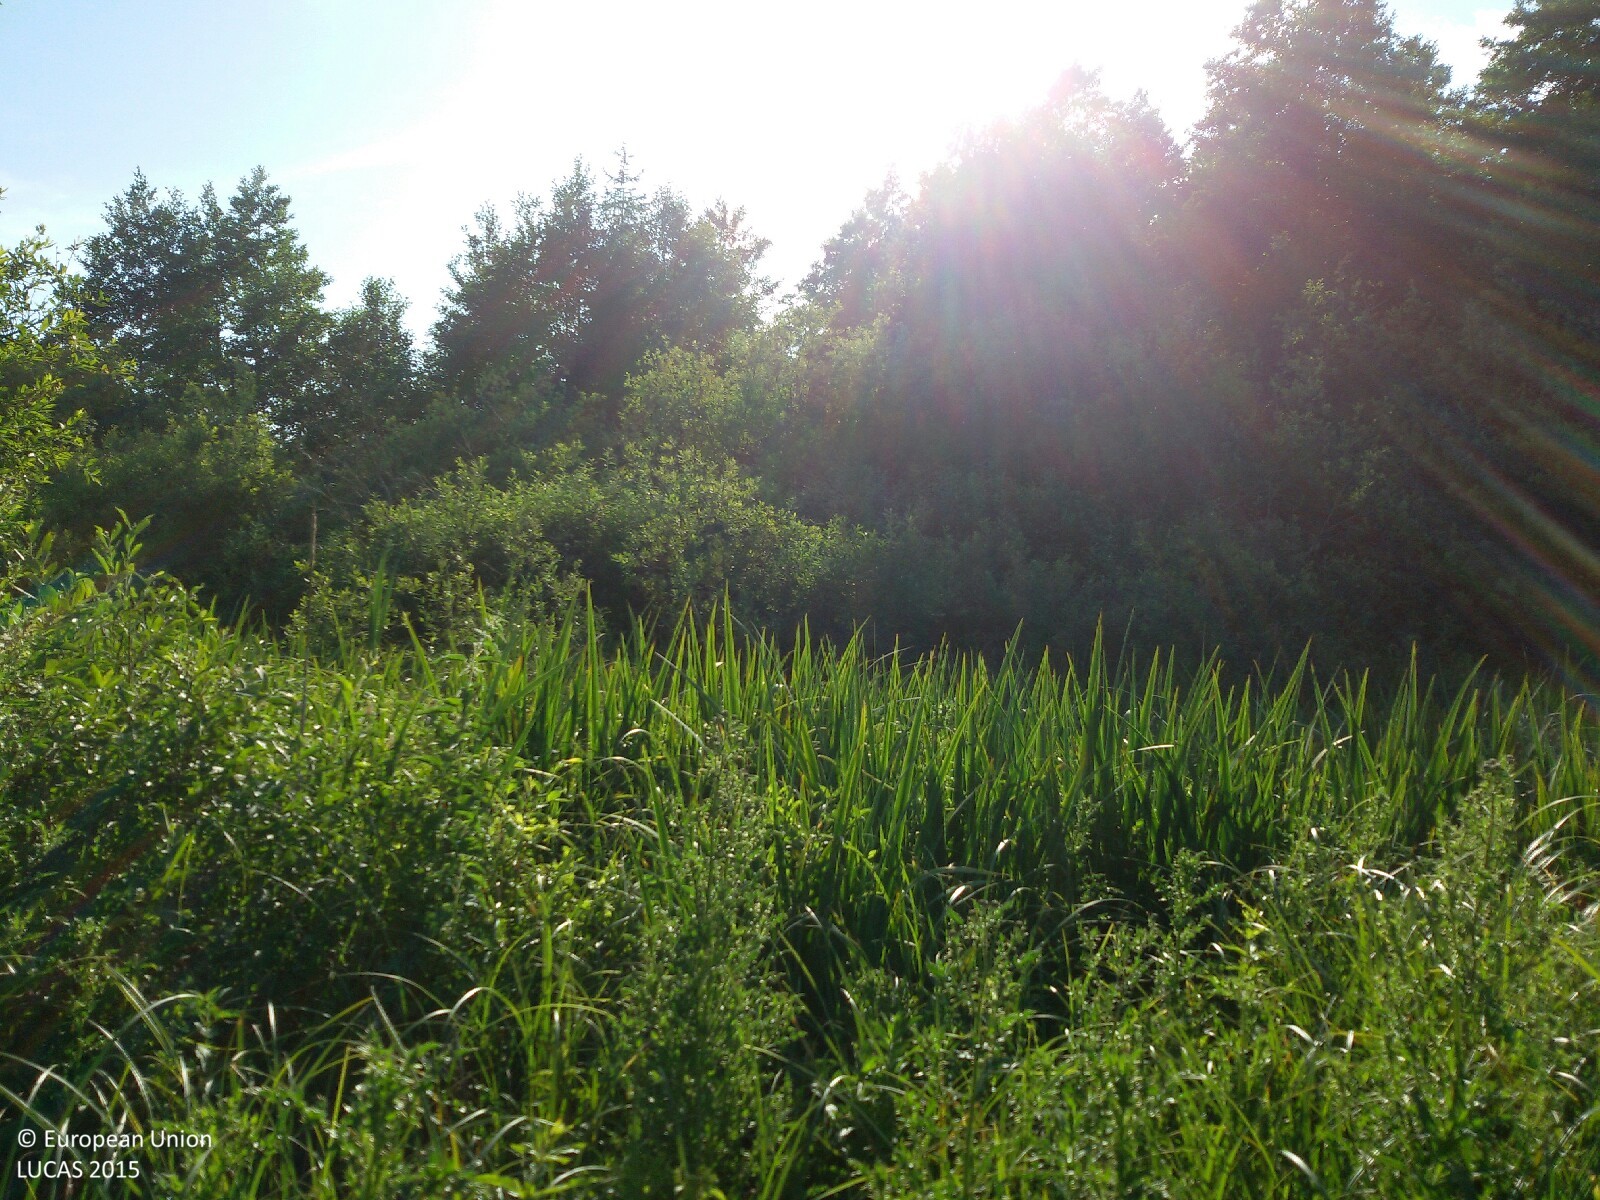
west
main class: Shrubland
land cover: Shrubland without tree cover
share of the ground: 50 - 75 %
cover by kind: shrubs 50 %, herbaceous plants 50 %
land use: Semi-natural and natural areas not in use
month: July
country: PL
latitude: 54.0153
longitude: 20.2742
